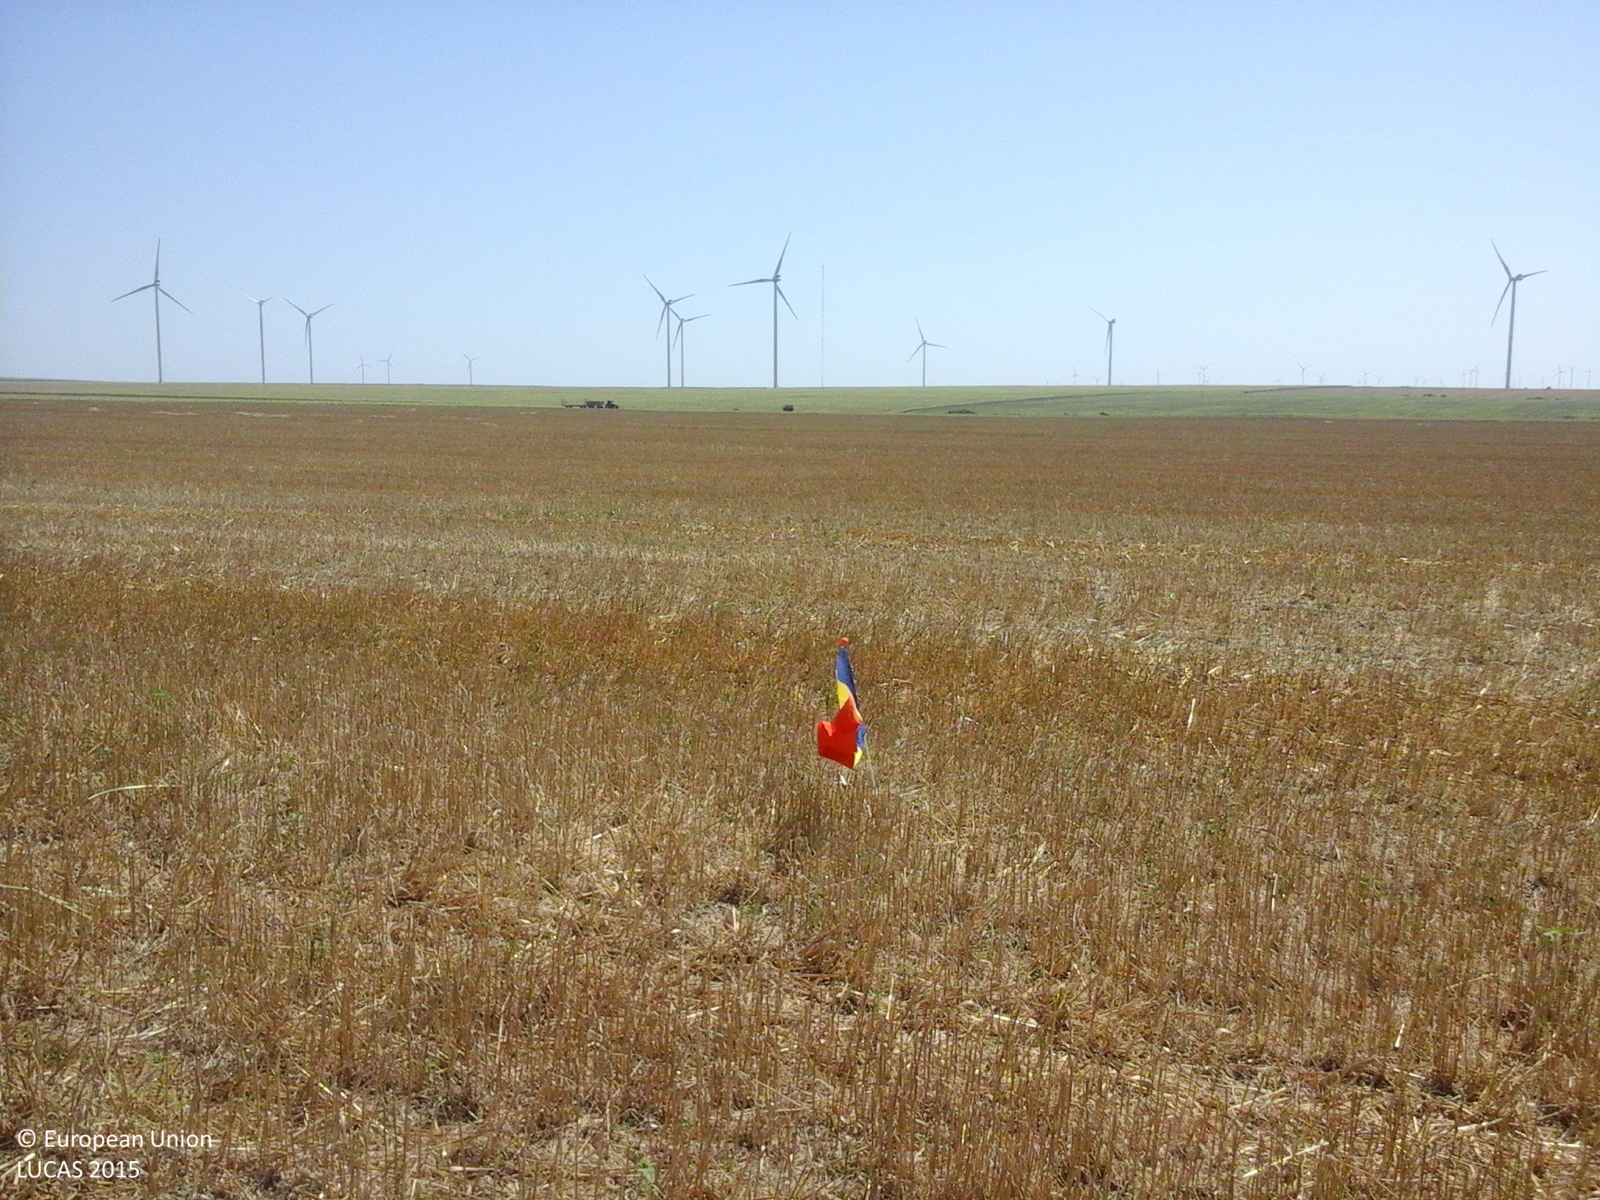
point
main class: Cropland
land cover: Common wheat
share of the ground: 50 - 75 %
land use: Agriculture (excluding fallow land and kitchen gardens)
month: August
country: RO
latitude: 44.5680
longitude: 28.2090
